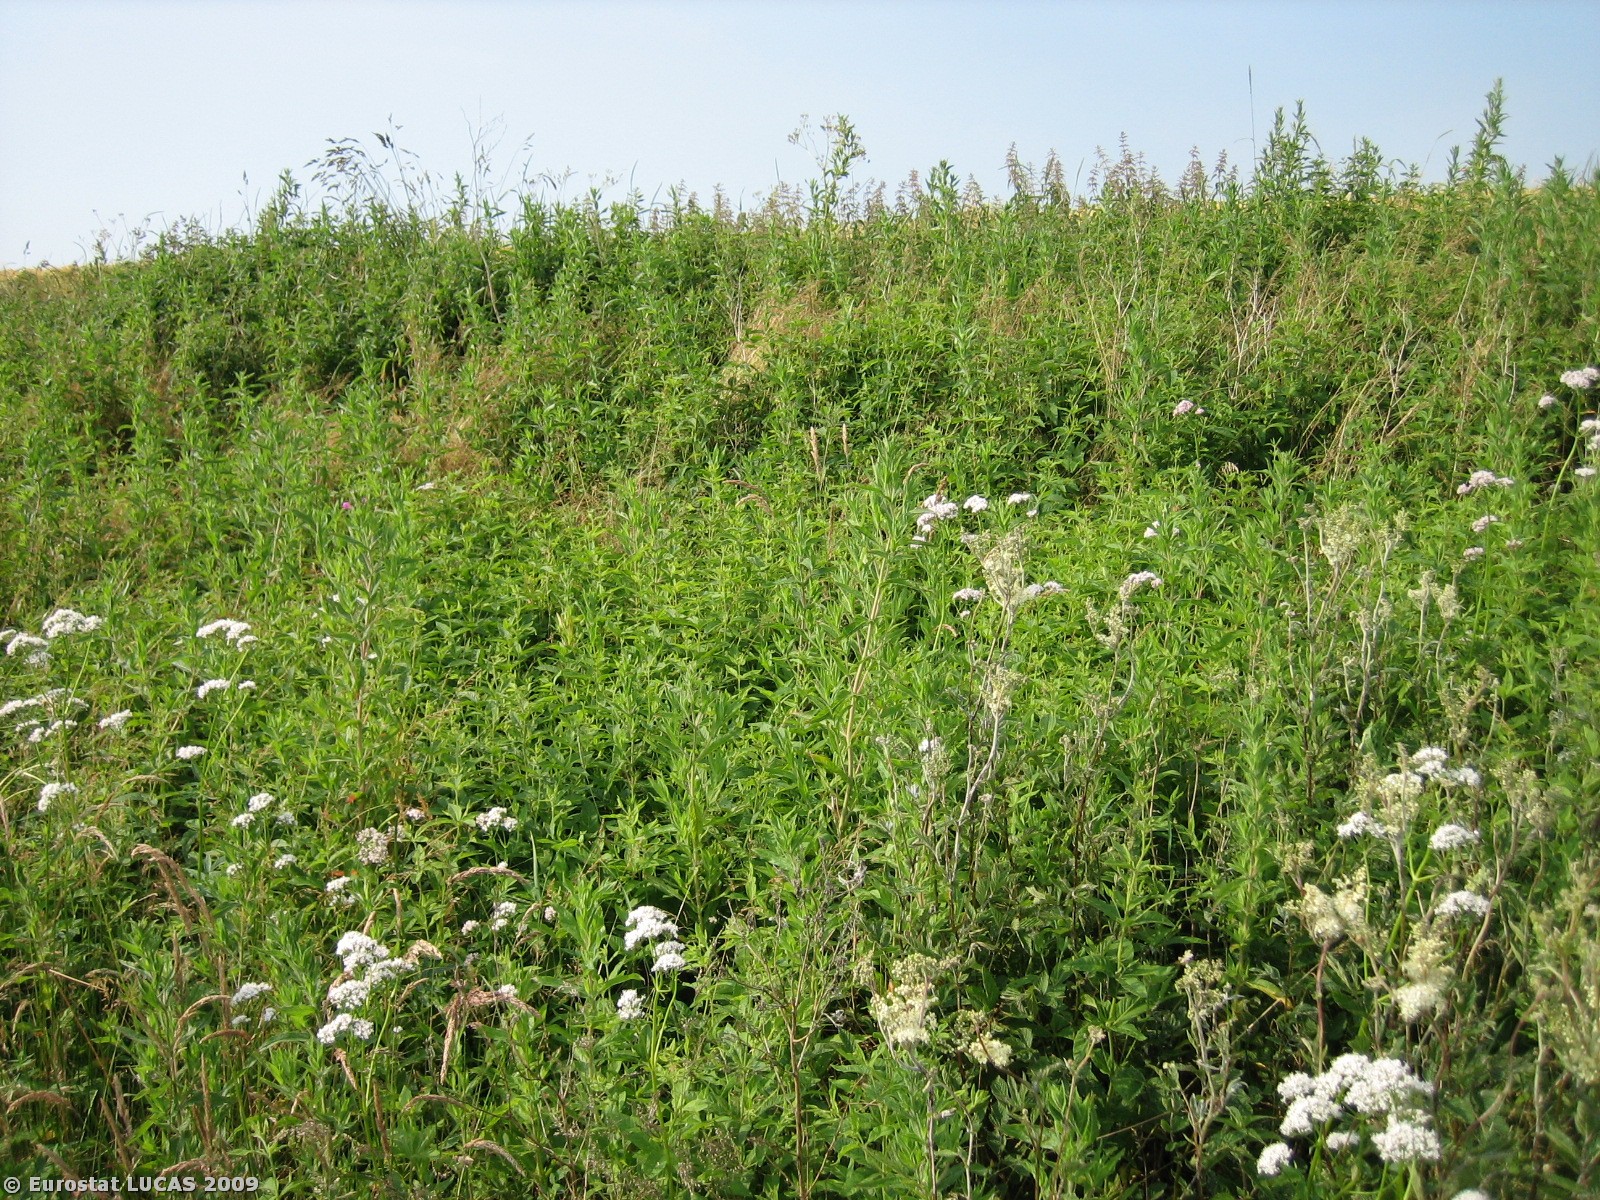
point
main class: Grassland
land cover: Grassland without tree/shrub cover
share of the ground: > 75 %
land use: Unused
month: July
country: DK
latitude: 55.3018
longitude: 8.8511
